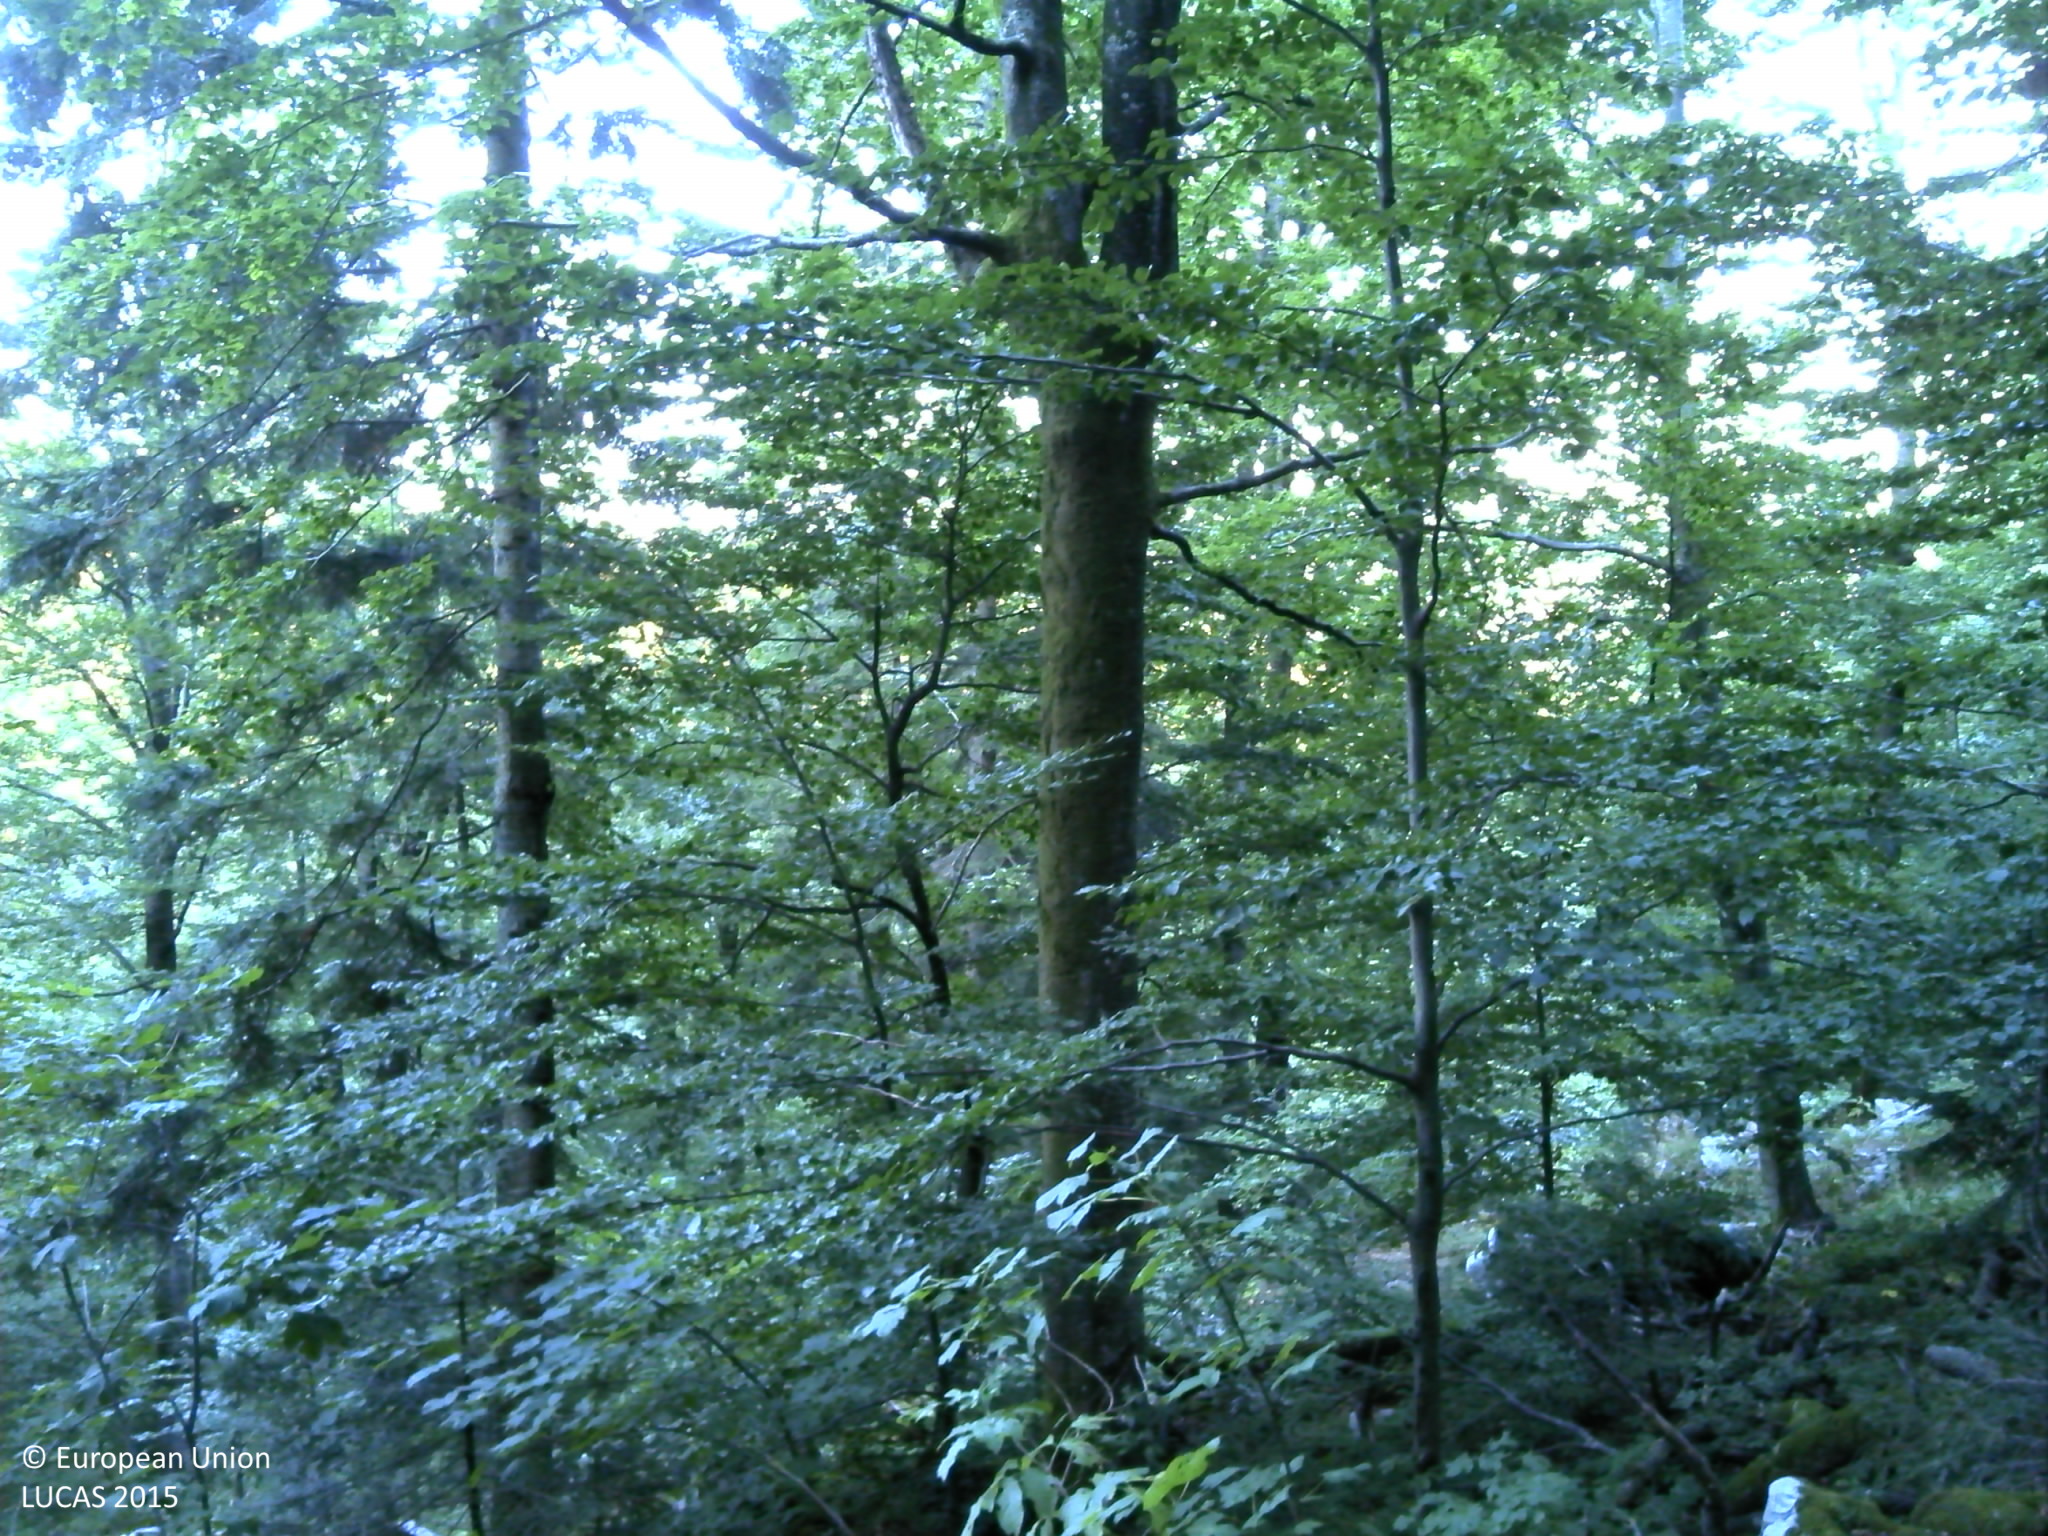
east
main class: Woodland
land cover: Other mixed woodland
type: mountainous beech forest
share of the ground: > 75 %
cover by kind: broadleaved forest trees 60 %, coniferous forest trees 30 %, herbaceous plants 5 %, unconsolidated bare surface 5 %
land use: Forestry
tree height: > 5 m
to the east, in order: Other mixed woodland; Tracks; Other mixed woodland
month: August
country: HR
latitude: 45.0952
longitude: 15.0393
